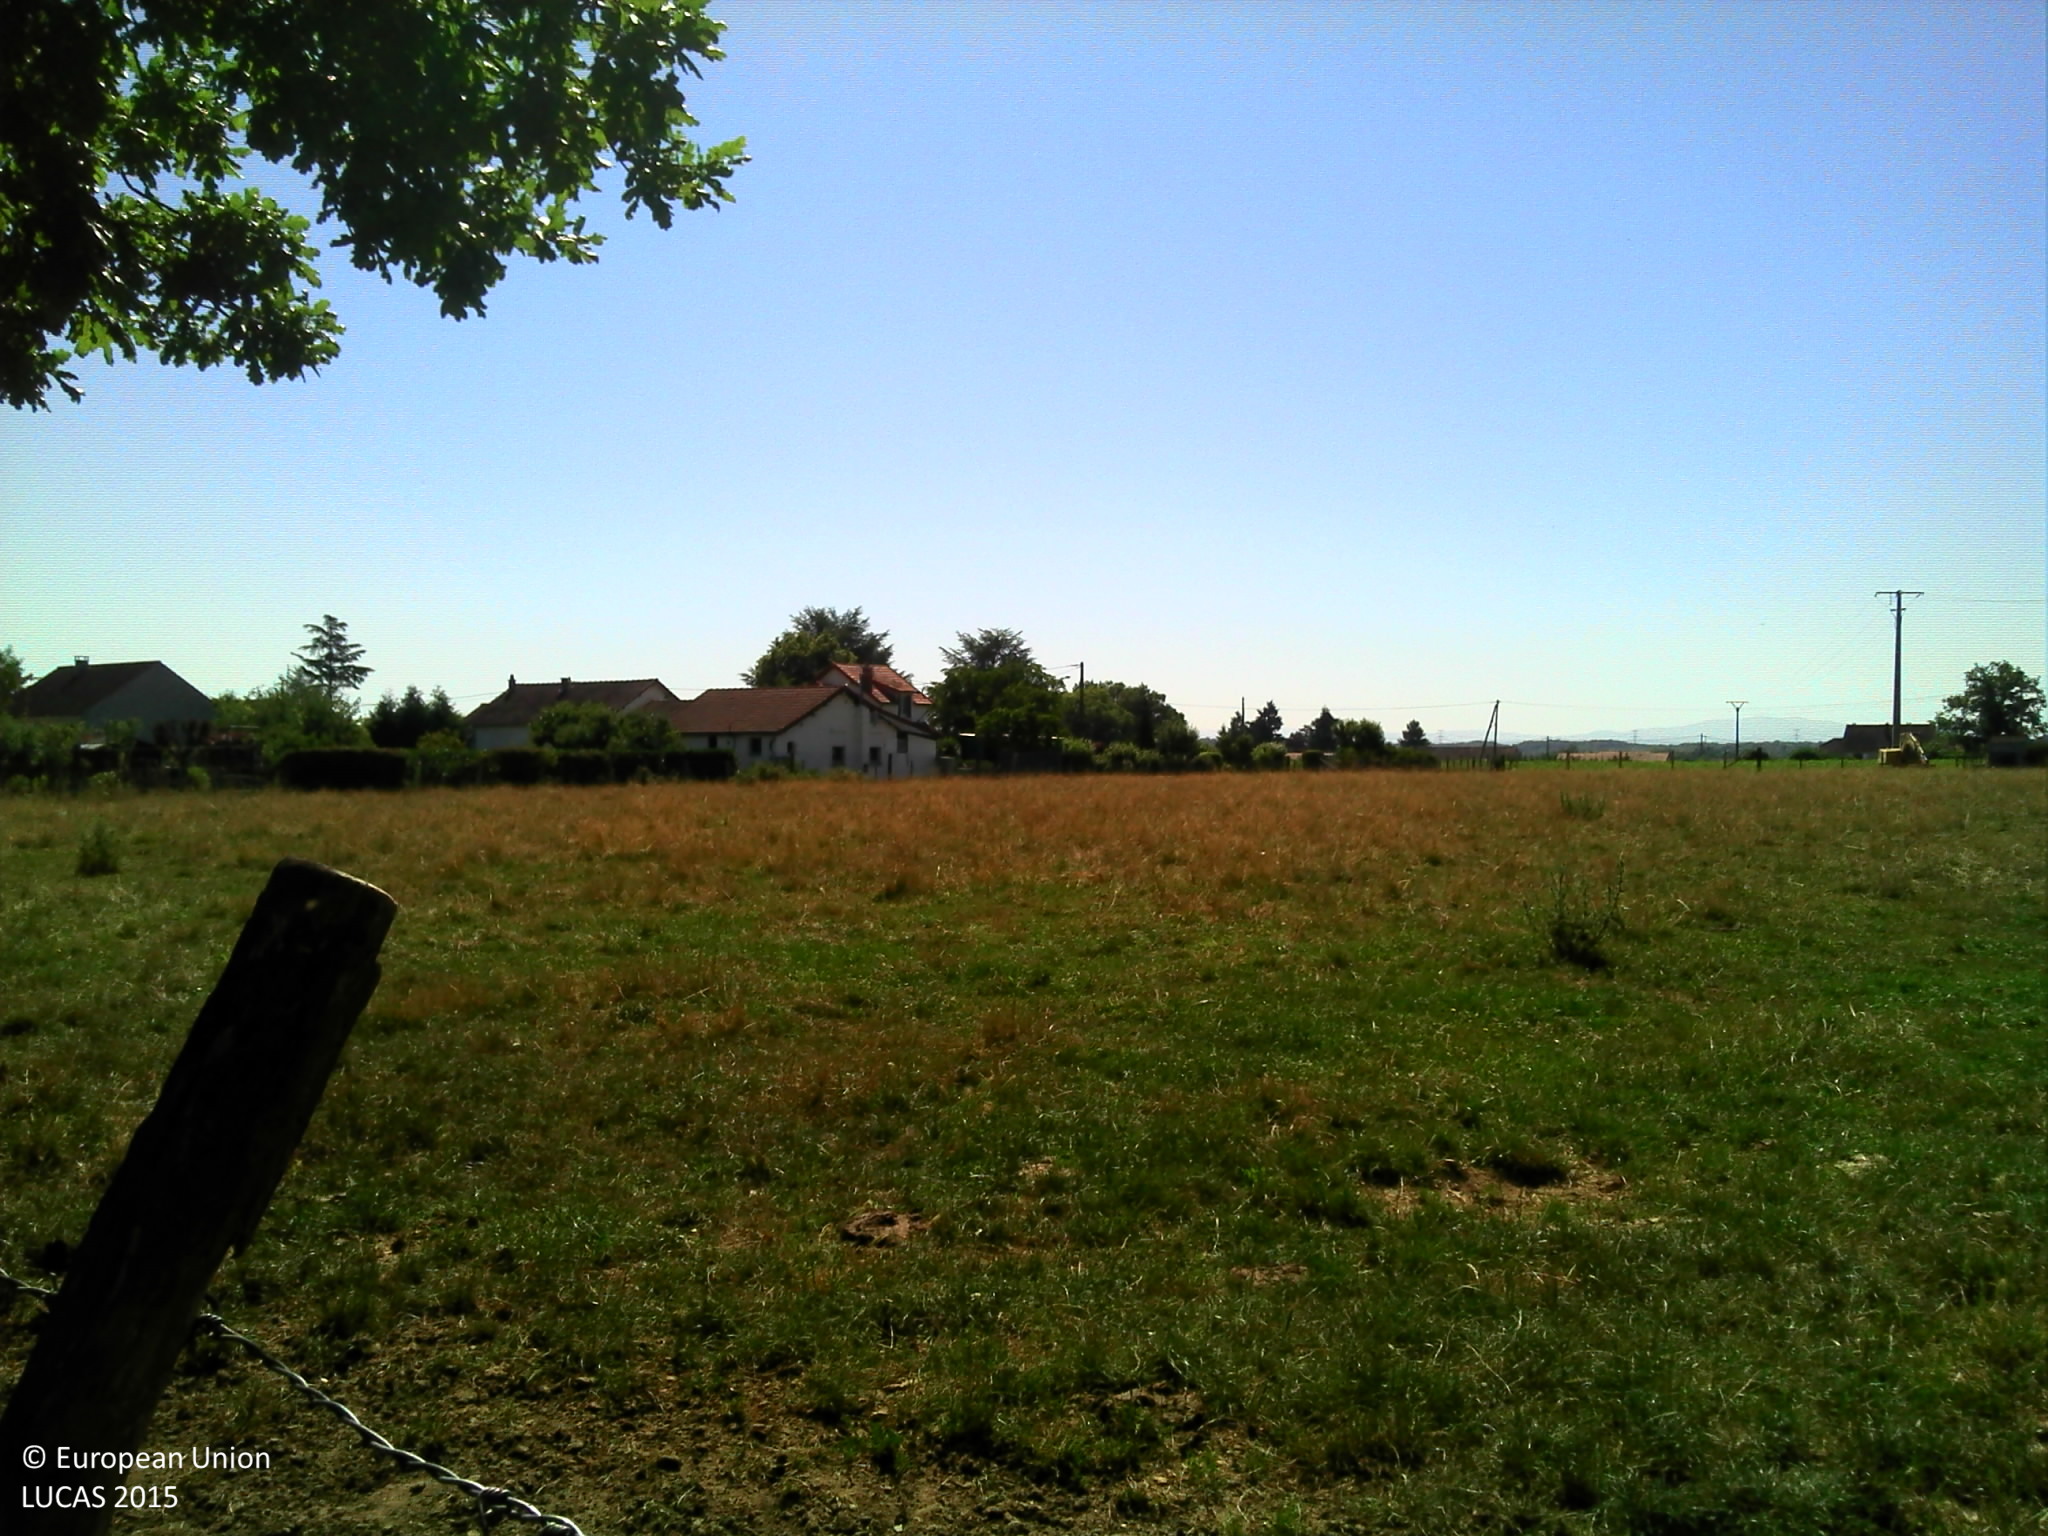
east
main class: Grassland
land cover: Grassland without tree/shrub cover
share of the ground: > 75 %
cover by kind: herbaceous plants 100 %
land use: Agriculture (excluding fallow land and kitchen gardens)
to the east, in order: Grassland without tree/shrub cover; Artificial constructions in urban areas; Ditches and canals; Grass margins; Paved roads, cycling and walking lanes; Grass margins; Ditches and canals; Sunflower; Managed hedges; Fences; Grassland without tree/shrub cover
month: June
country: FR
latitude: 46.1936
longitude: 3.2740
